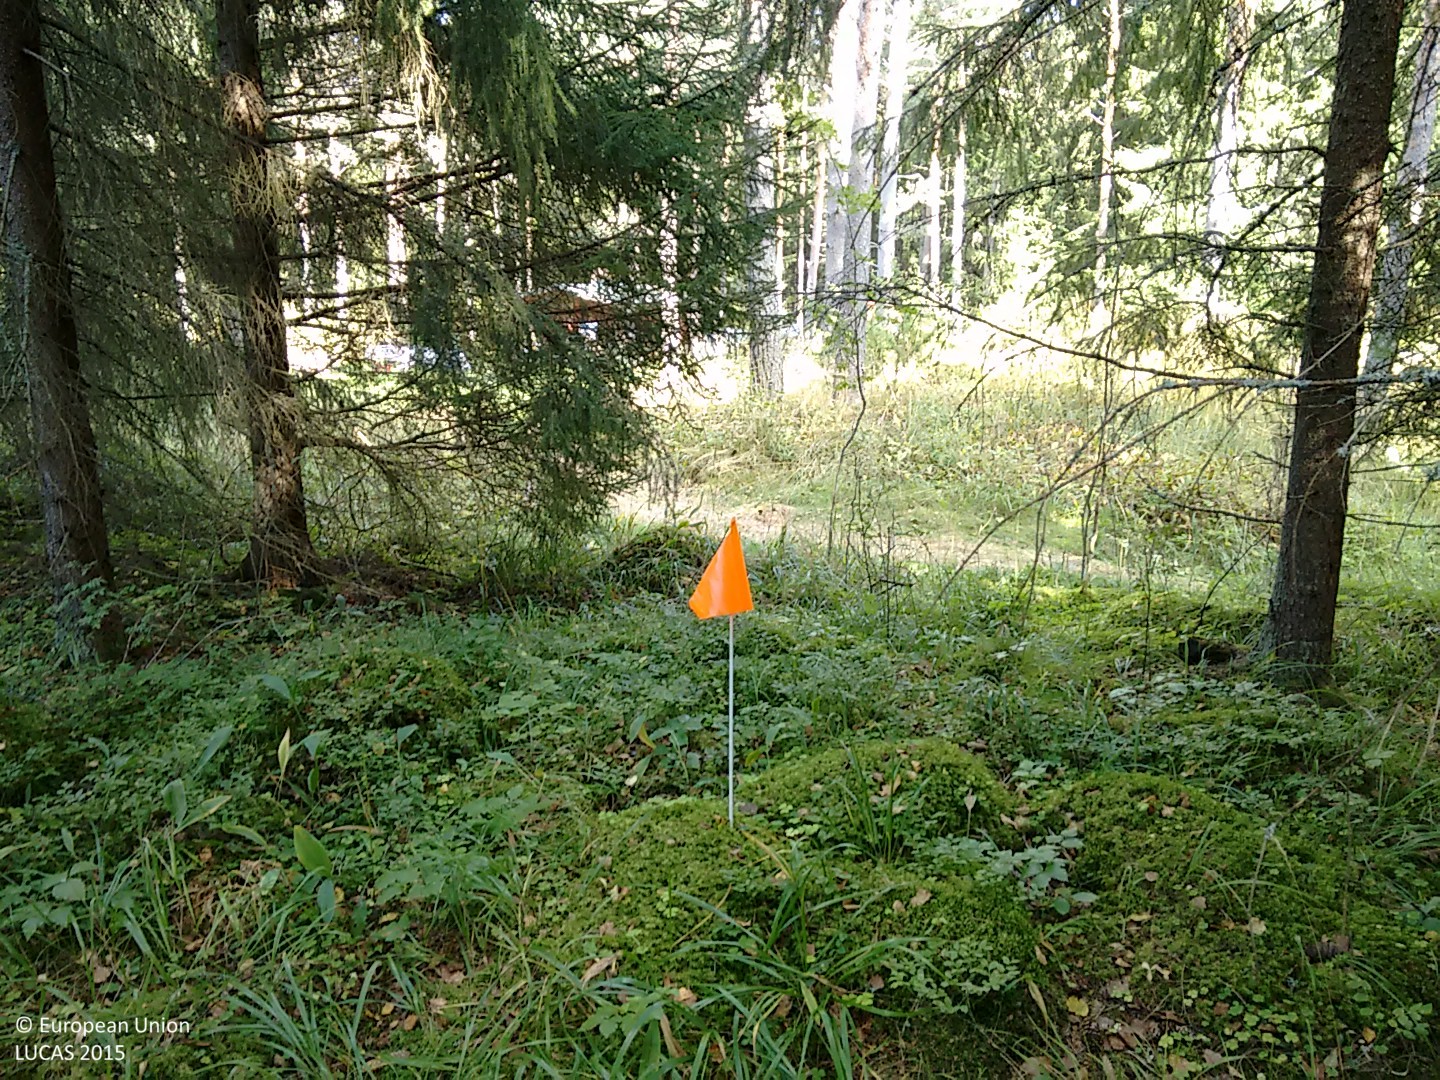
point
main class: Woodland
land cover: Spruce dominated coniferous woodland
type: hemiboreal forest and nemoral coniferous forest and mixed broadleaved-coniferous forest
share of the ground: > 75 %
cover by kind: coniferous forest trees 85 %, herbaceous plants 15 %
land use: Forestry
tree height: > 5 m
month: September
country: FI
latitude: 60.9317
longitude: 21.4751
